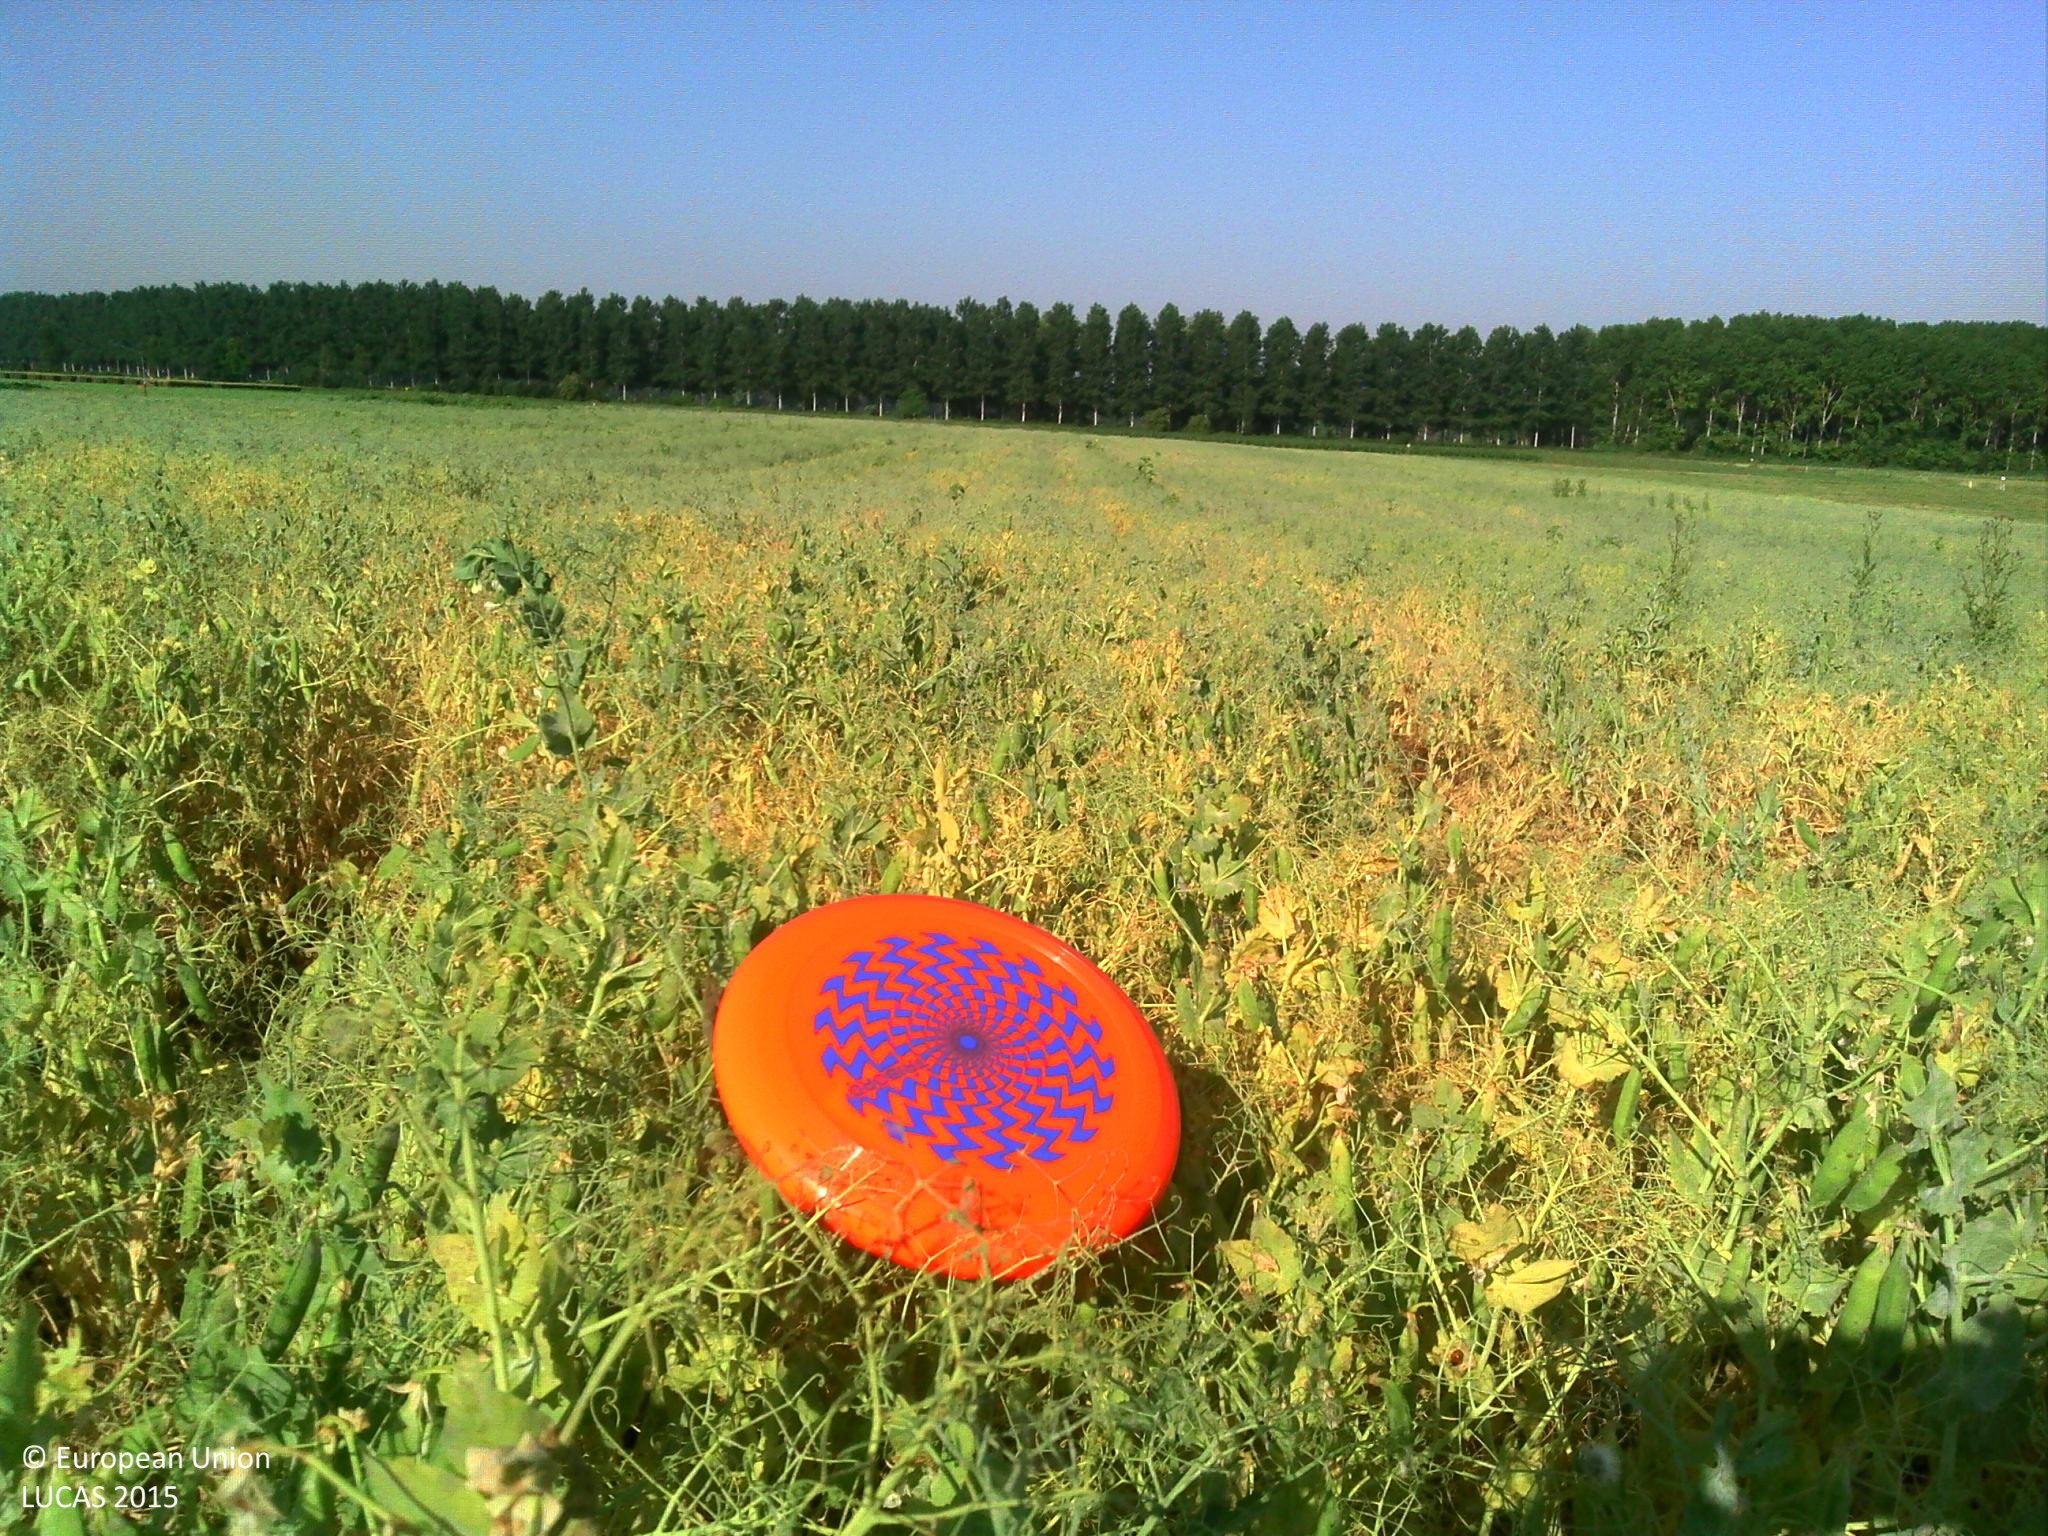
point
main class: Cropland
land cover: Dry pulses
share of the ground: > 75 %
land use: Agriculture (excluding fallow land and kitchen gardens)
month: June
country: FR
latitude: 43.8022
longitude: 1.2876
